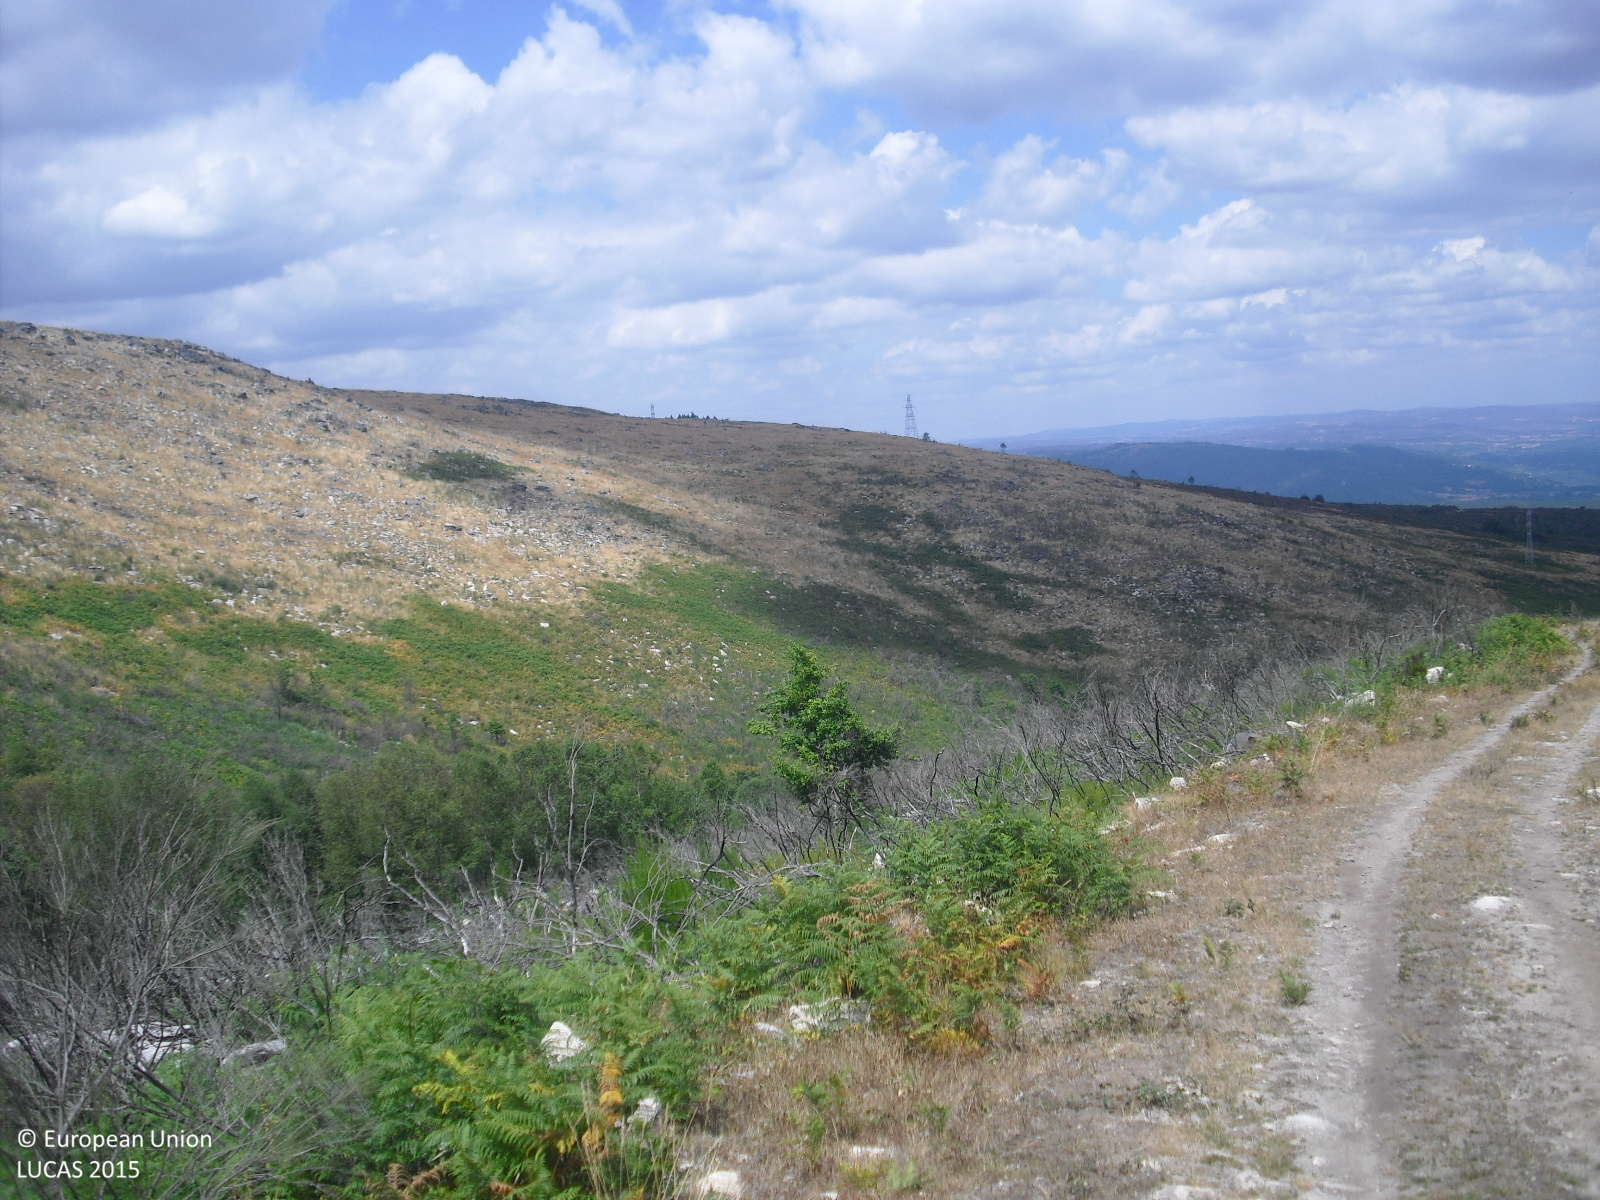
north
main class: Shrubland
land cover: Shrubland without tree cover
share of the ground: > 75 %
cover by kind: shrubs 100 %
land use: Semi-natural and natural areas not in use
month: July
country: ES
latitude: 42.3944
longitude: -7.6751
